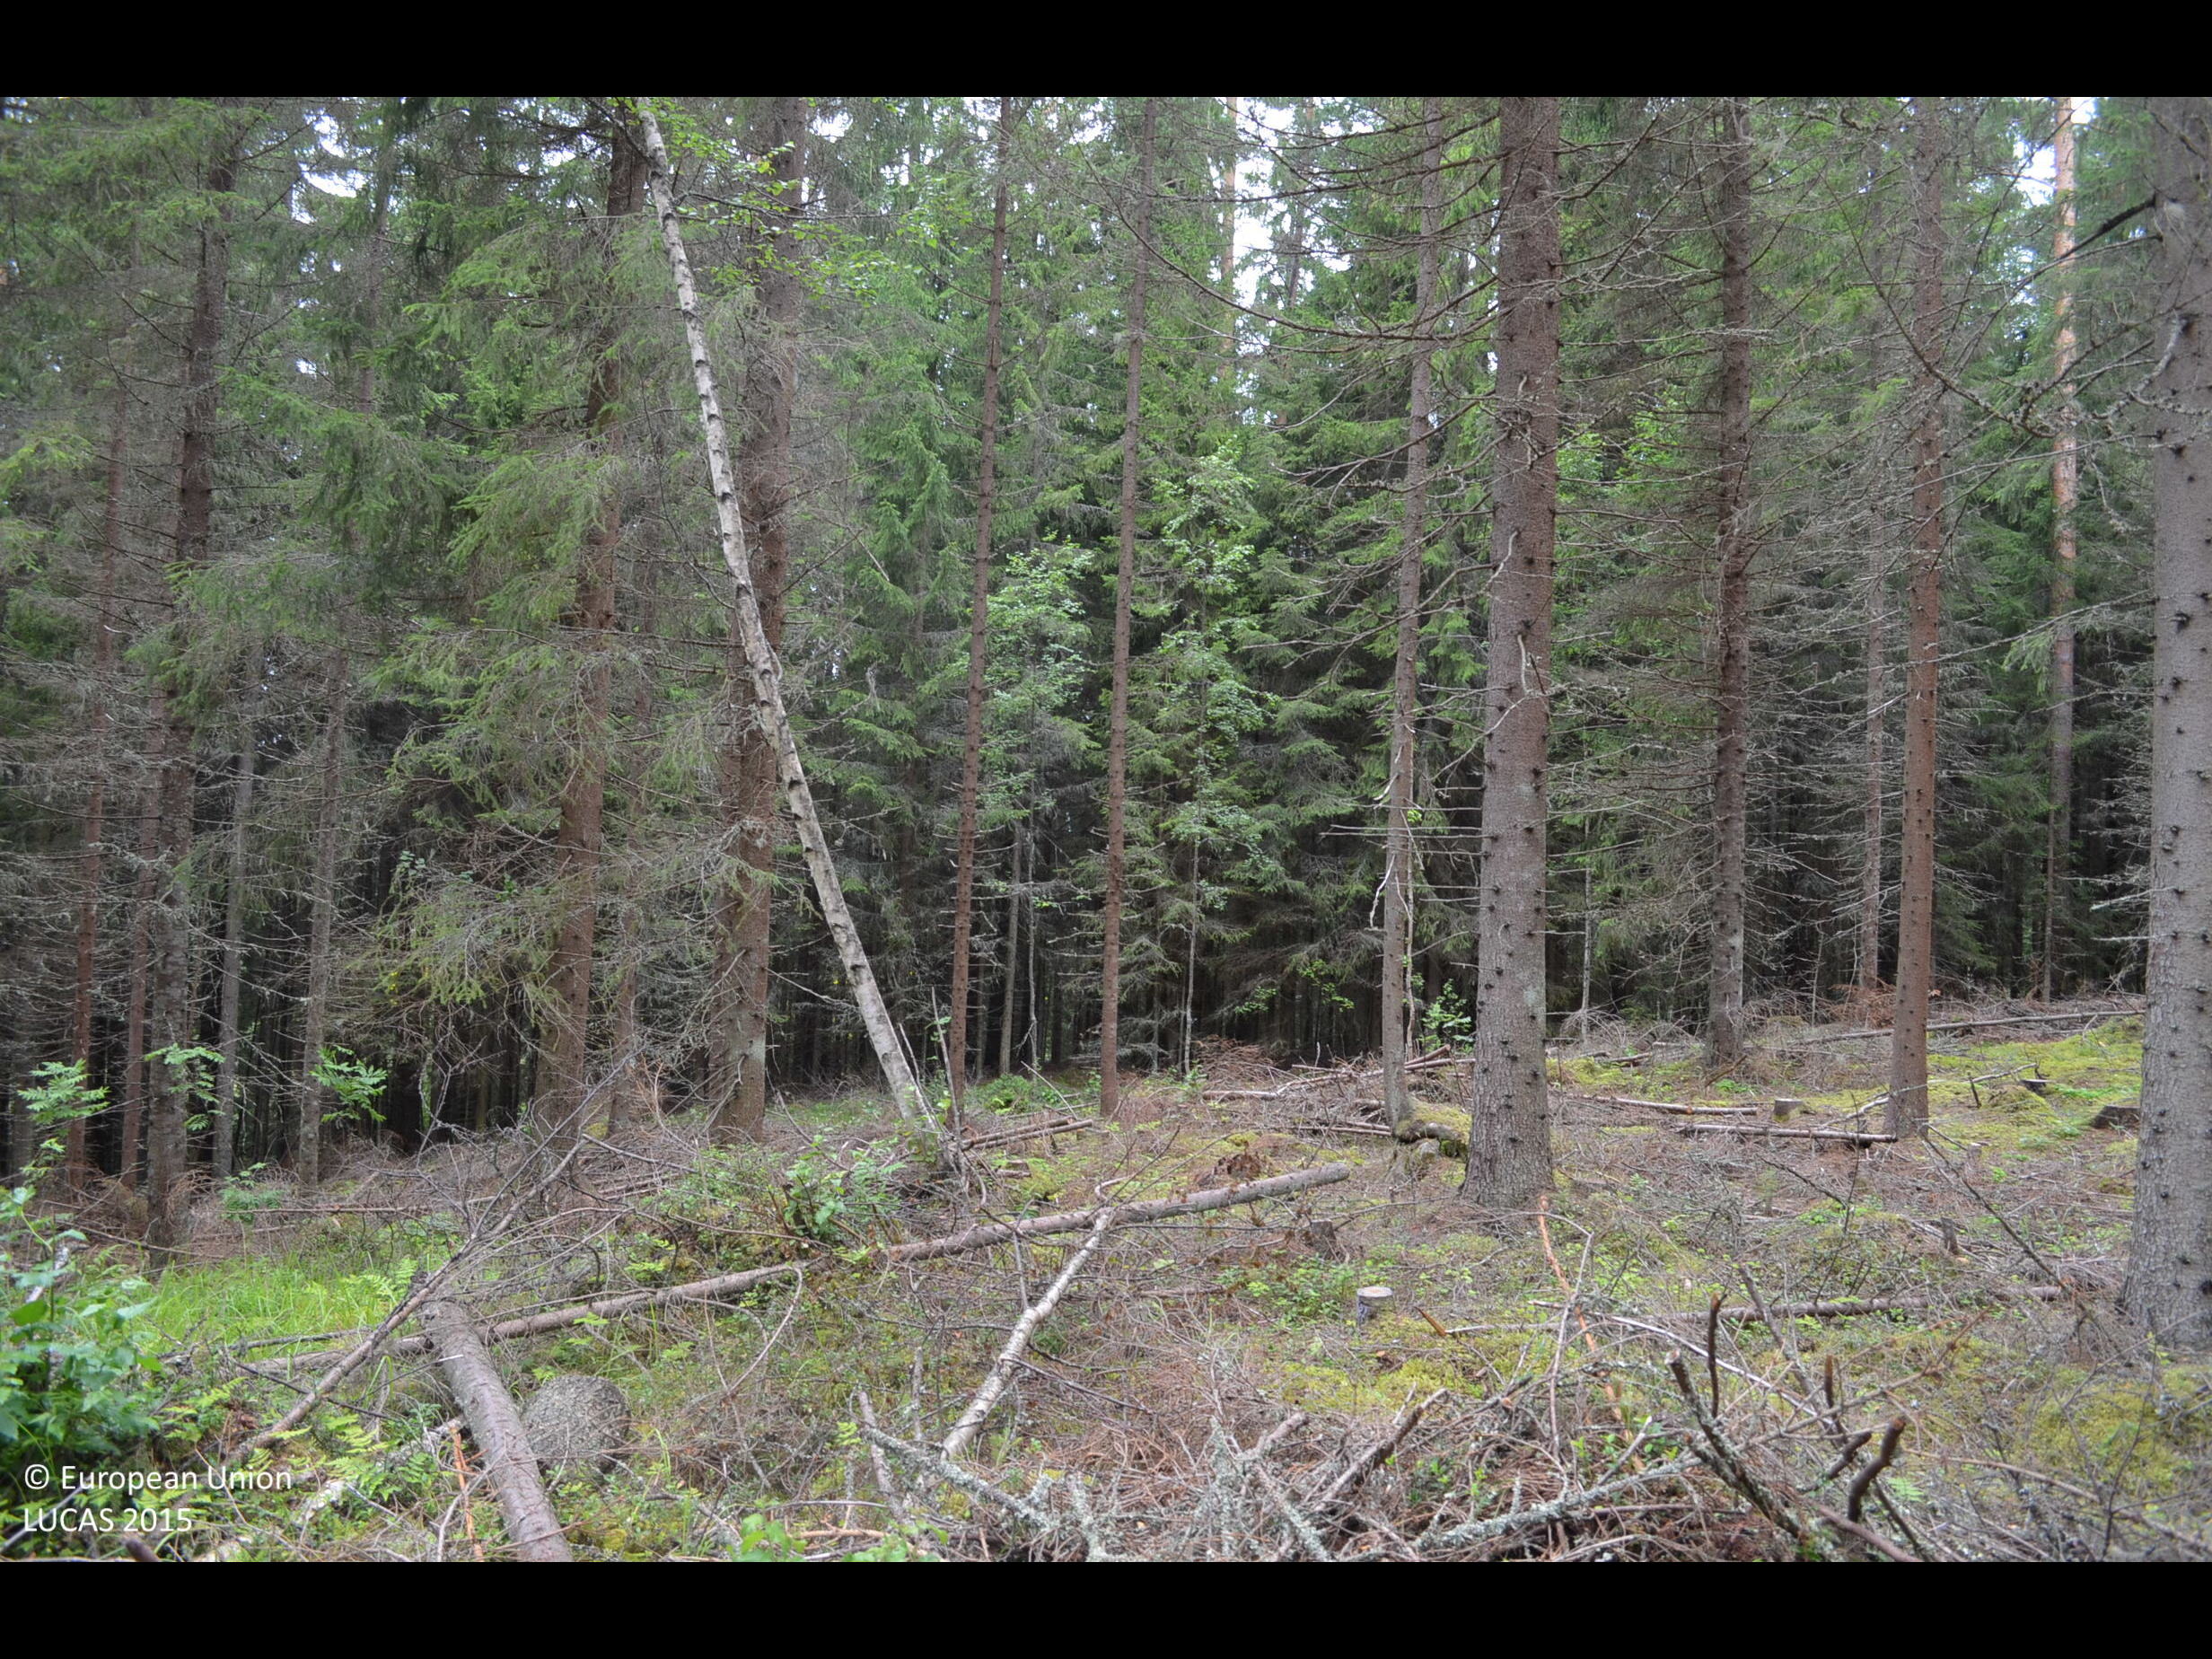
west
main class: Woodland
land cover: Spruce dominated coniferous woodland
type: boreal forest
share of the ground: 50 - 75 %
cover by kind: coniferous forest trees 65 %, shrubs 10 %, herbaceous plants 5 %, lichens and mosses 5 %
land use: Forestry
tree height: > 5 m
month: August
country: FI
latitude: 61.8919
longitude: 24.0711
